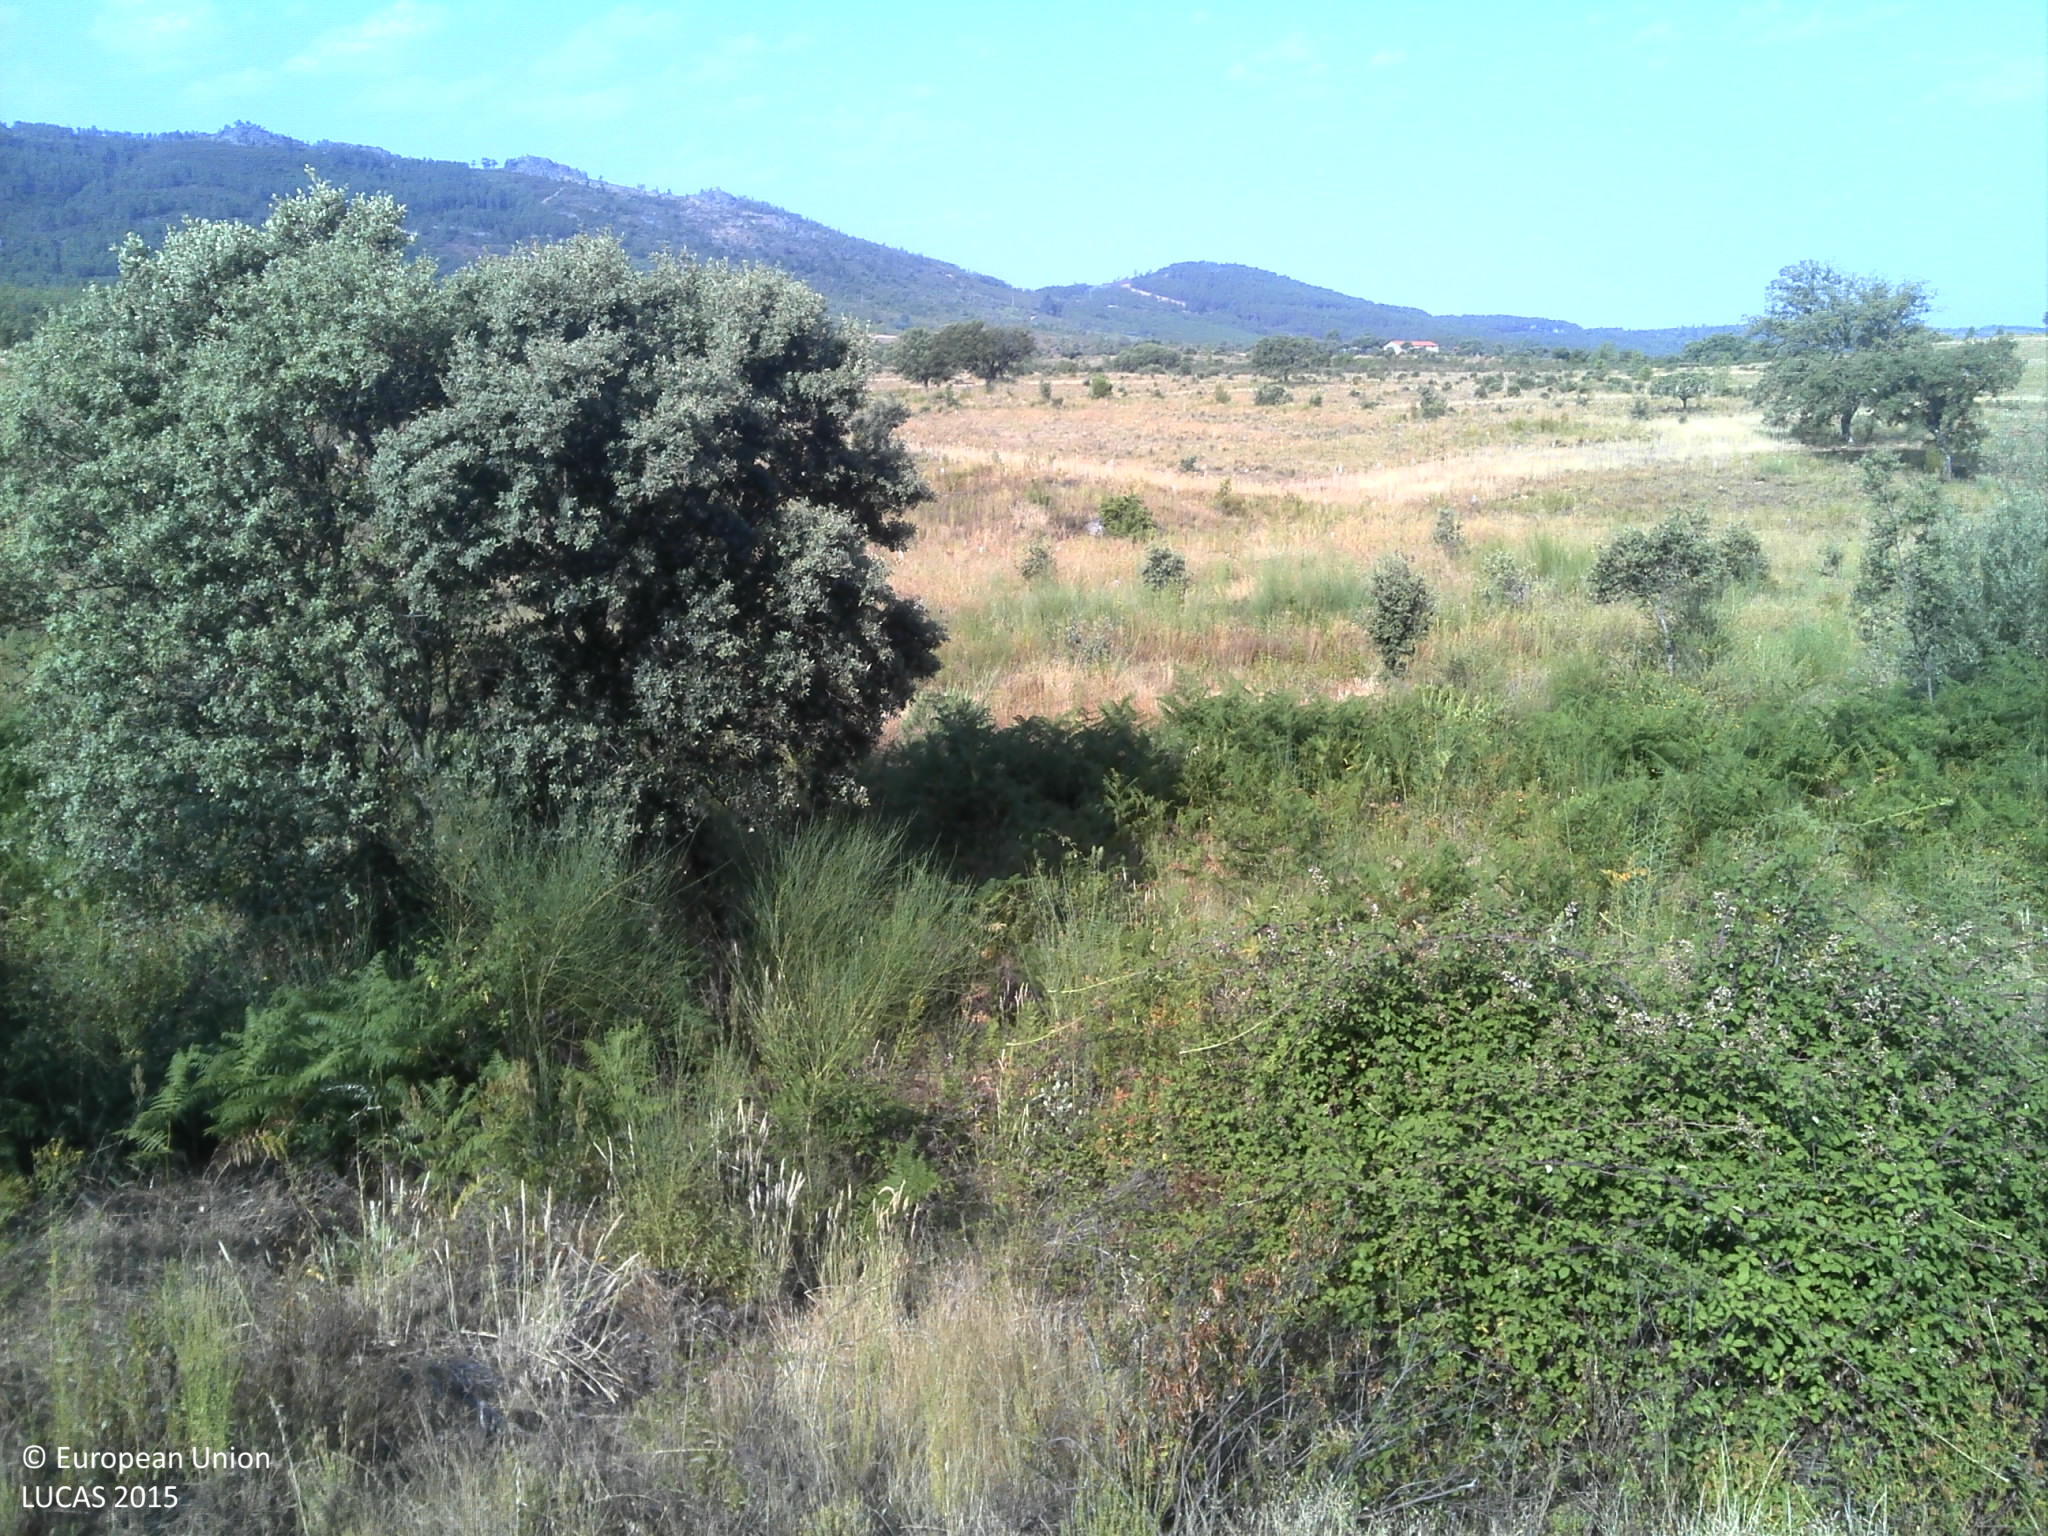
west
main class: Shrubland
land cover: Shrubland with sparse tree cover
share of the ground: 50 - 75 %
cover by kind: shrubs 60 %, unconsolidated bare surface 30 %, broadleaved forest trees 5 %, herbaceous plants 5 %
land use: Forestry
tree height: < 5 m
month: June
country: PT
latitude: 40.1052
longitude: -7.0690
